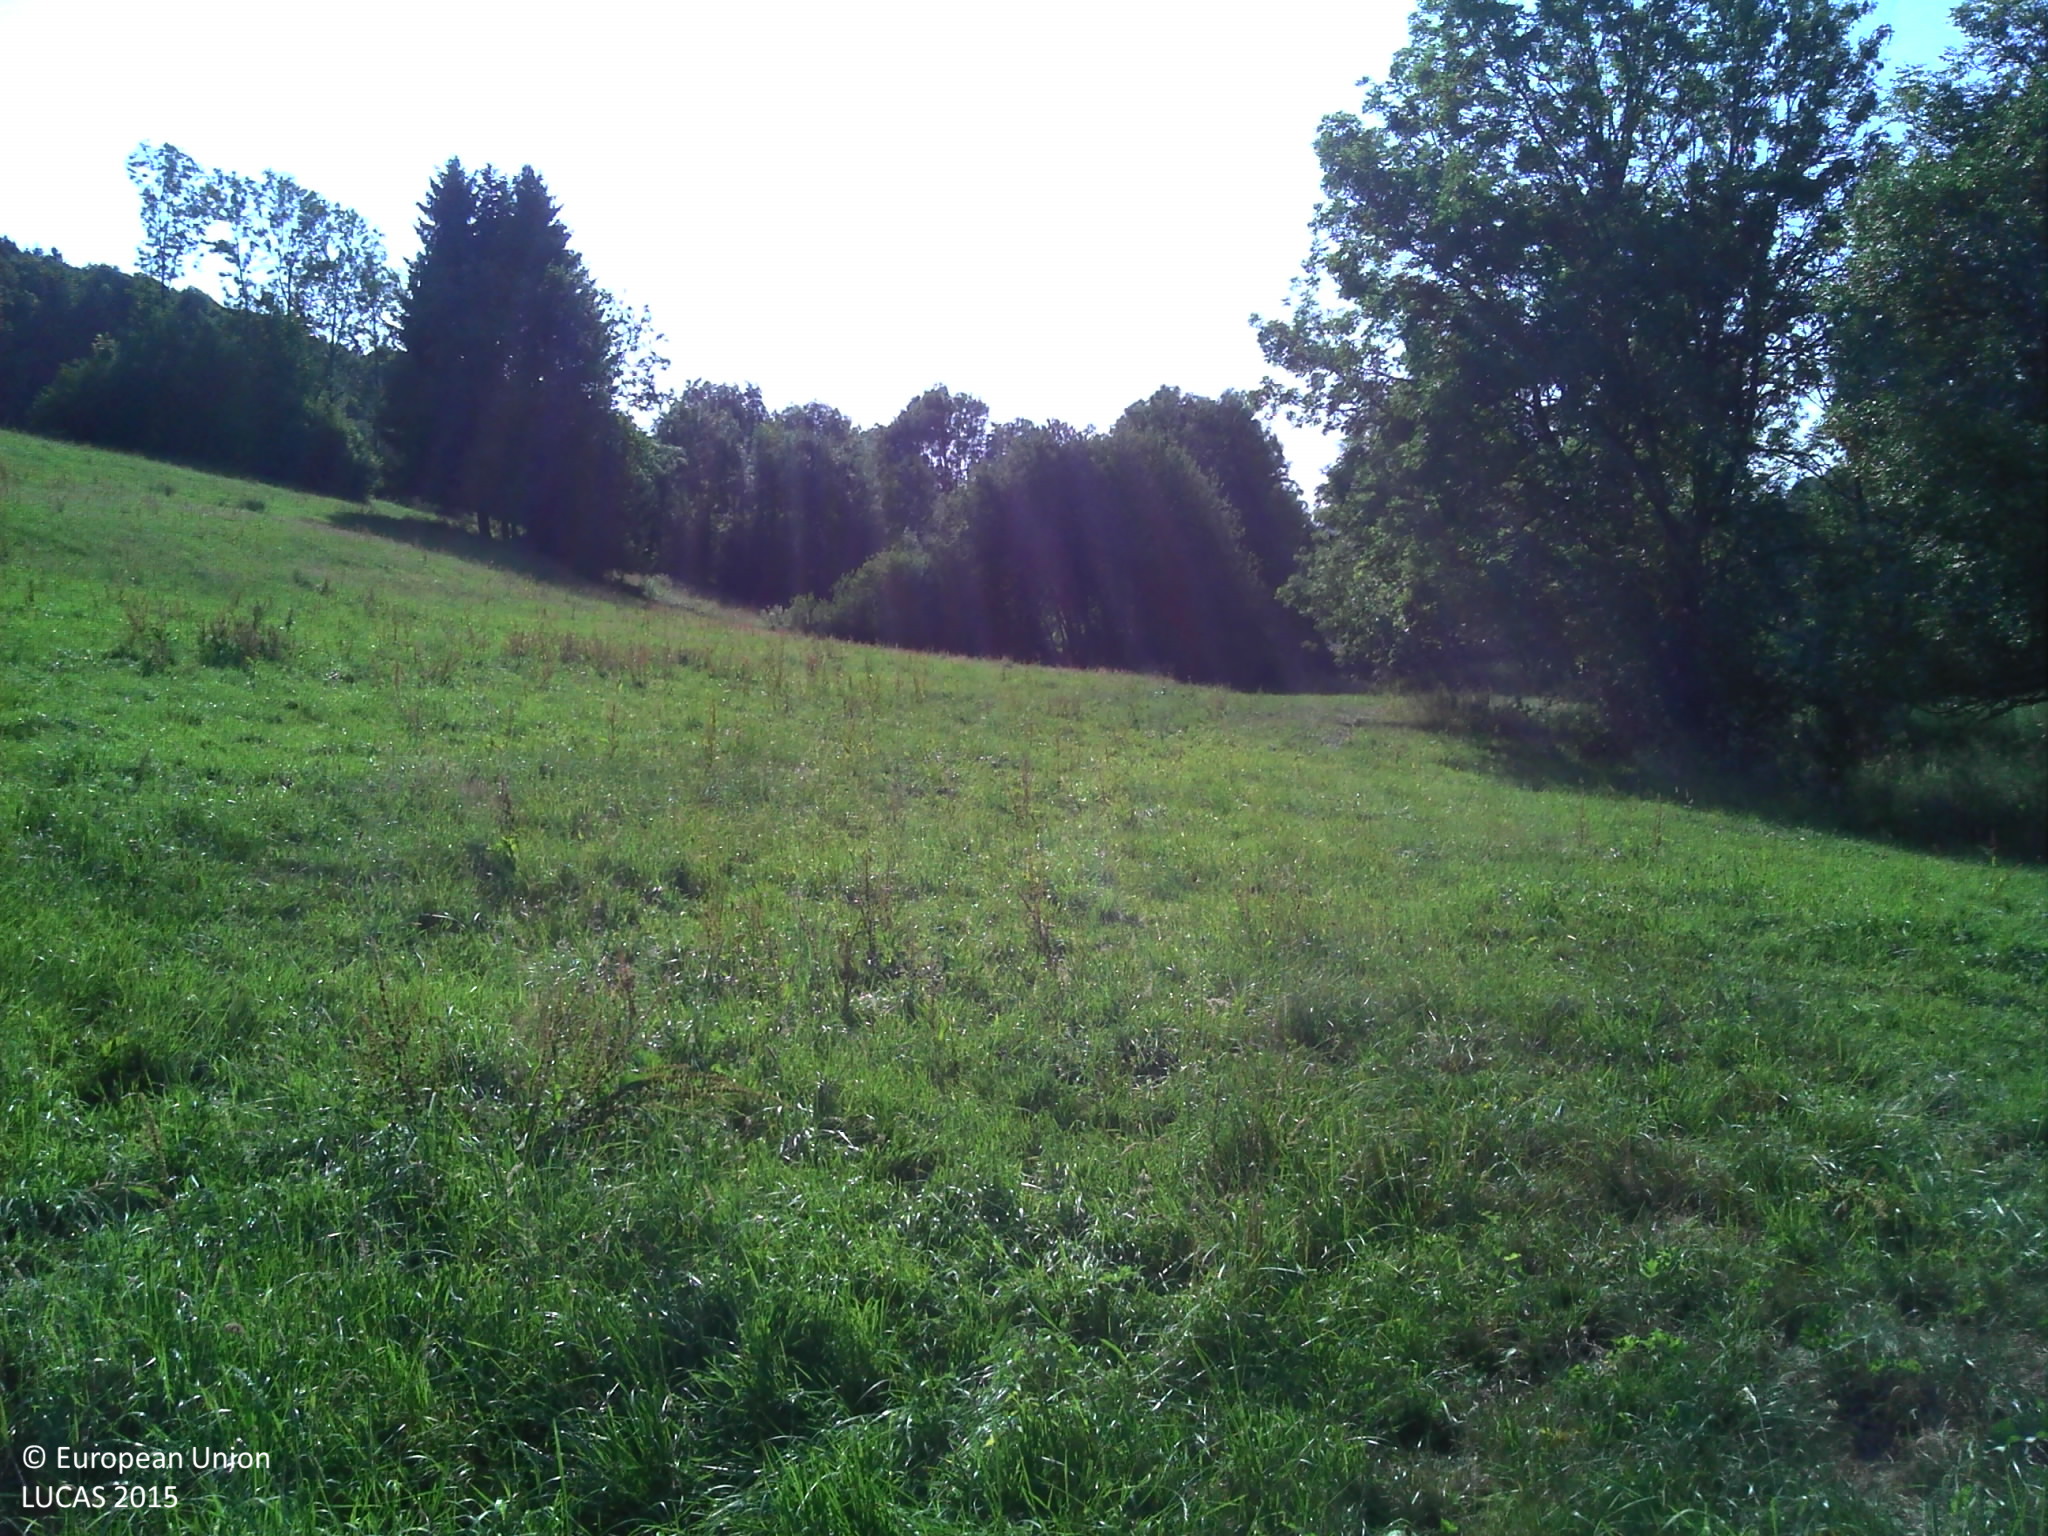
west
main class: Grassland
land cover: Grassland without tree/shrub cover
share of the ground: > 75 %
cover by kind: herbaceous plants 100 %
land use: Agriculture (excluding fallow land and kitchen gardens)
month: July
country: FR
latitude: 46.7845
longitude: 6.0860
